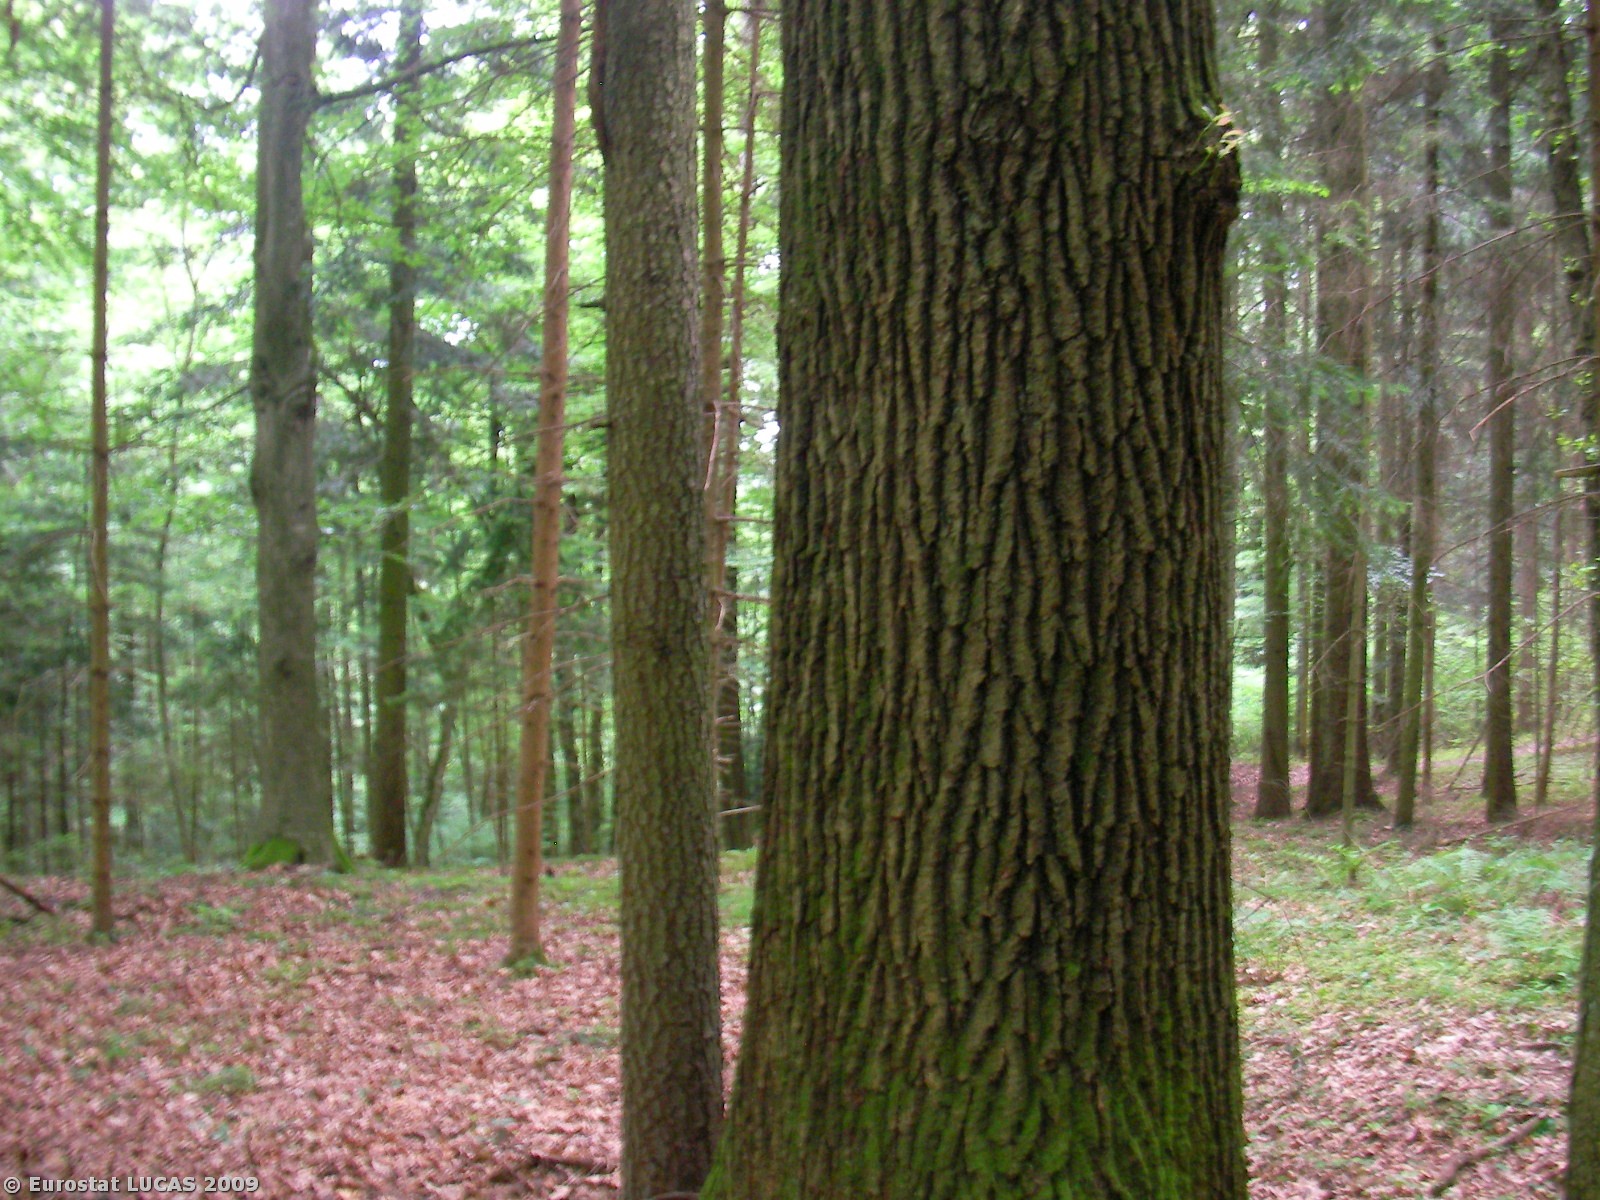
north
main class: Woodland
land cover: Mixed woodland
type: hemiboreal forest and nemoral coniferous forest and mixed broadleaved-coniferous forest
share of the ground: > 75 %
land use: Forestry
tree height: > 5 m
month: June
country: AT
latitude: 47.0642
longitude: 15.7281
